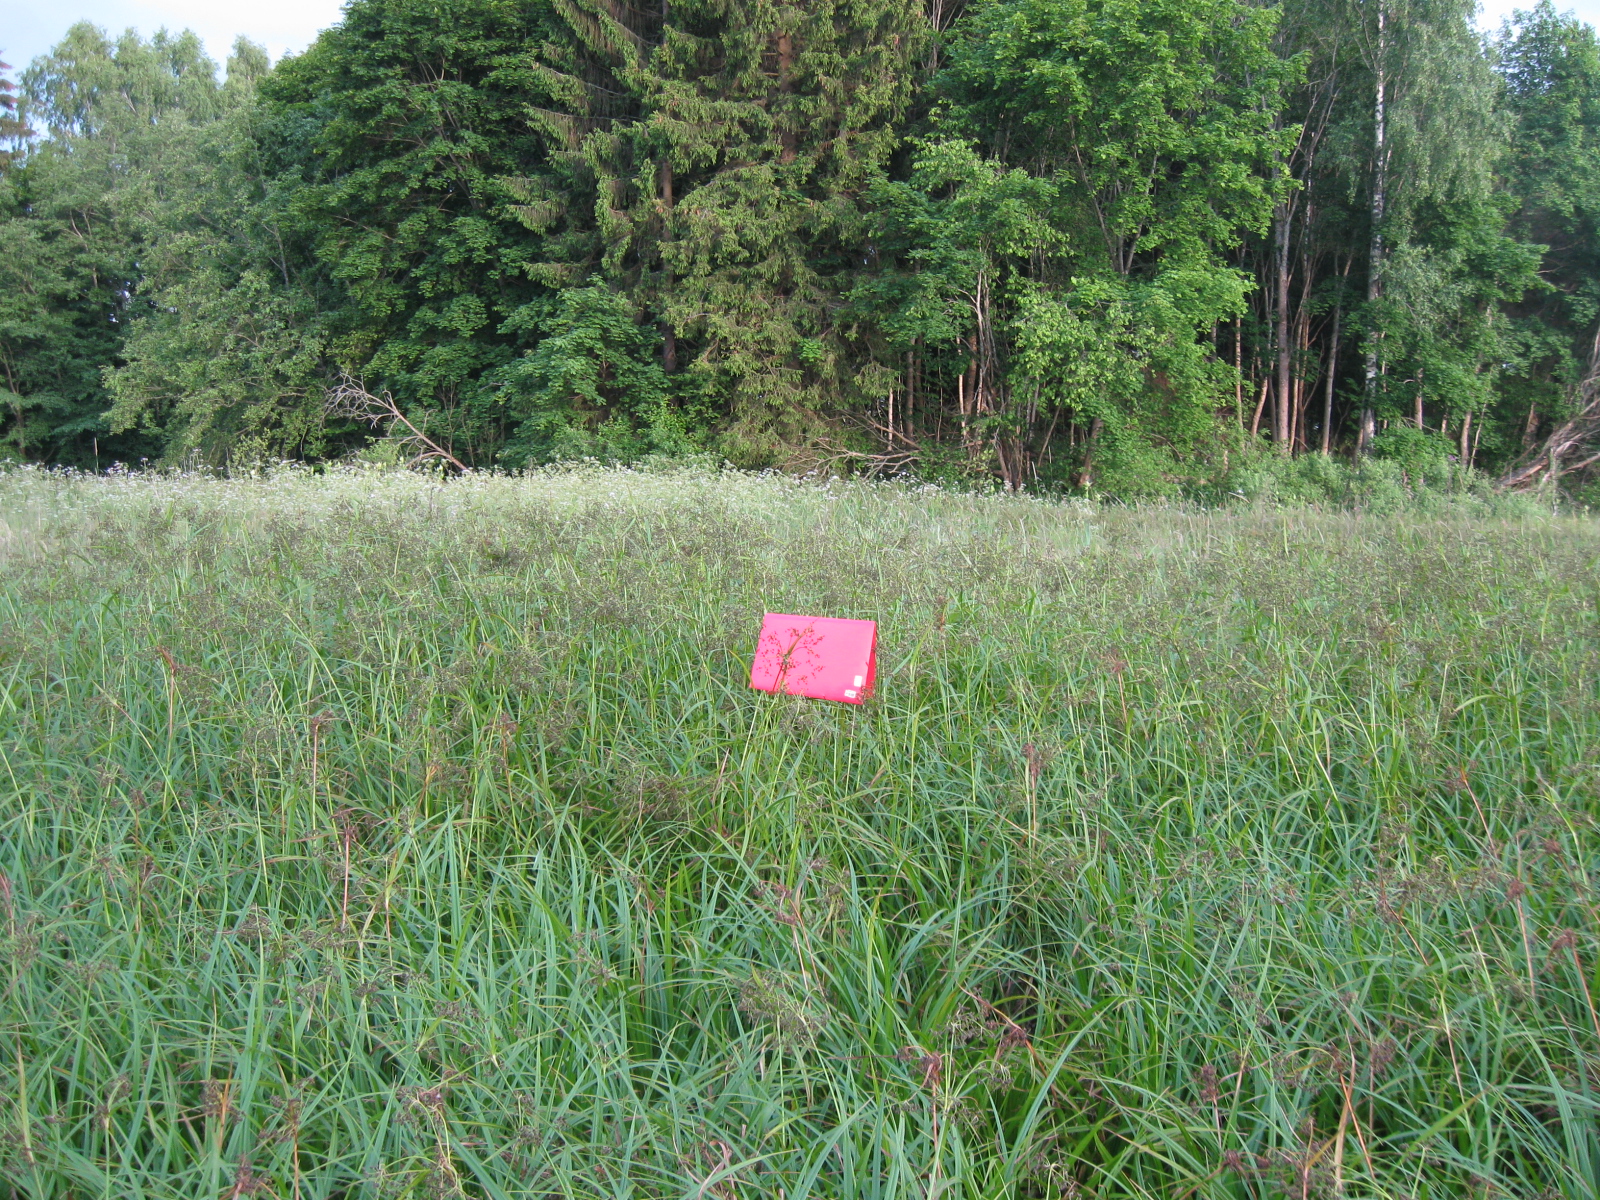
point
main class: Grassland
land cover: Spontaneously vegetated surfaces
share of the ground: > 75 %
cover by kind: herbaceous plants 100 %
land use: Semi-natural and natural areas not in use
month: June
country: LT
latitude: 54.5913
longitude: 24.6379
